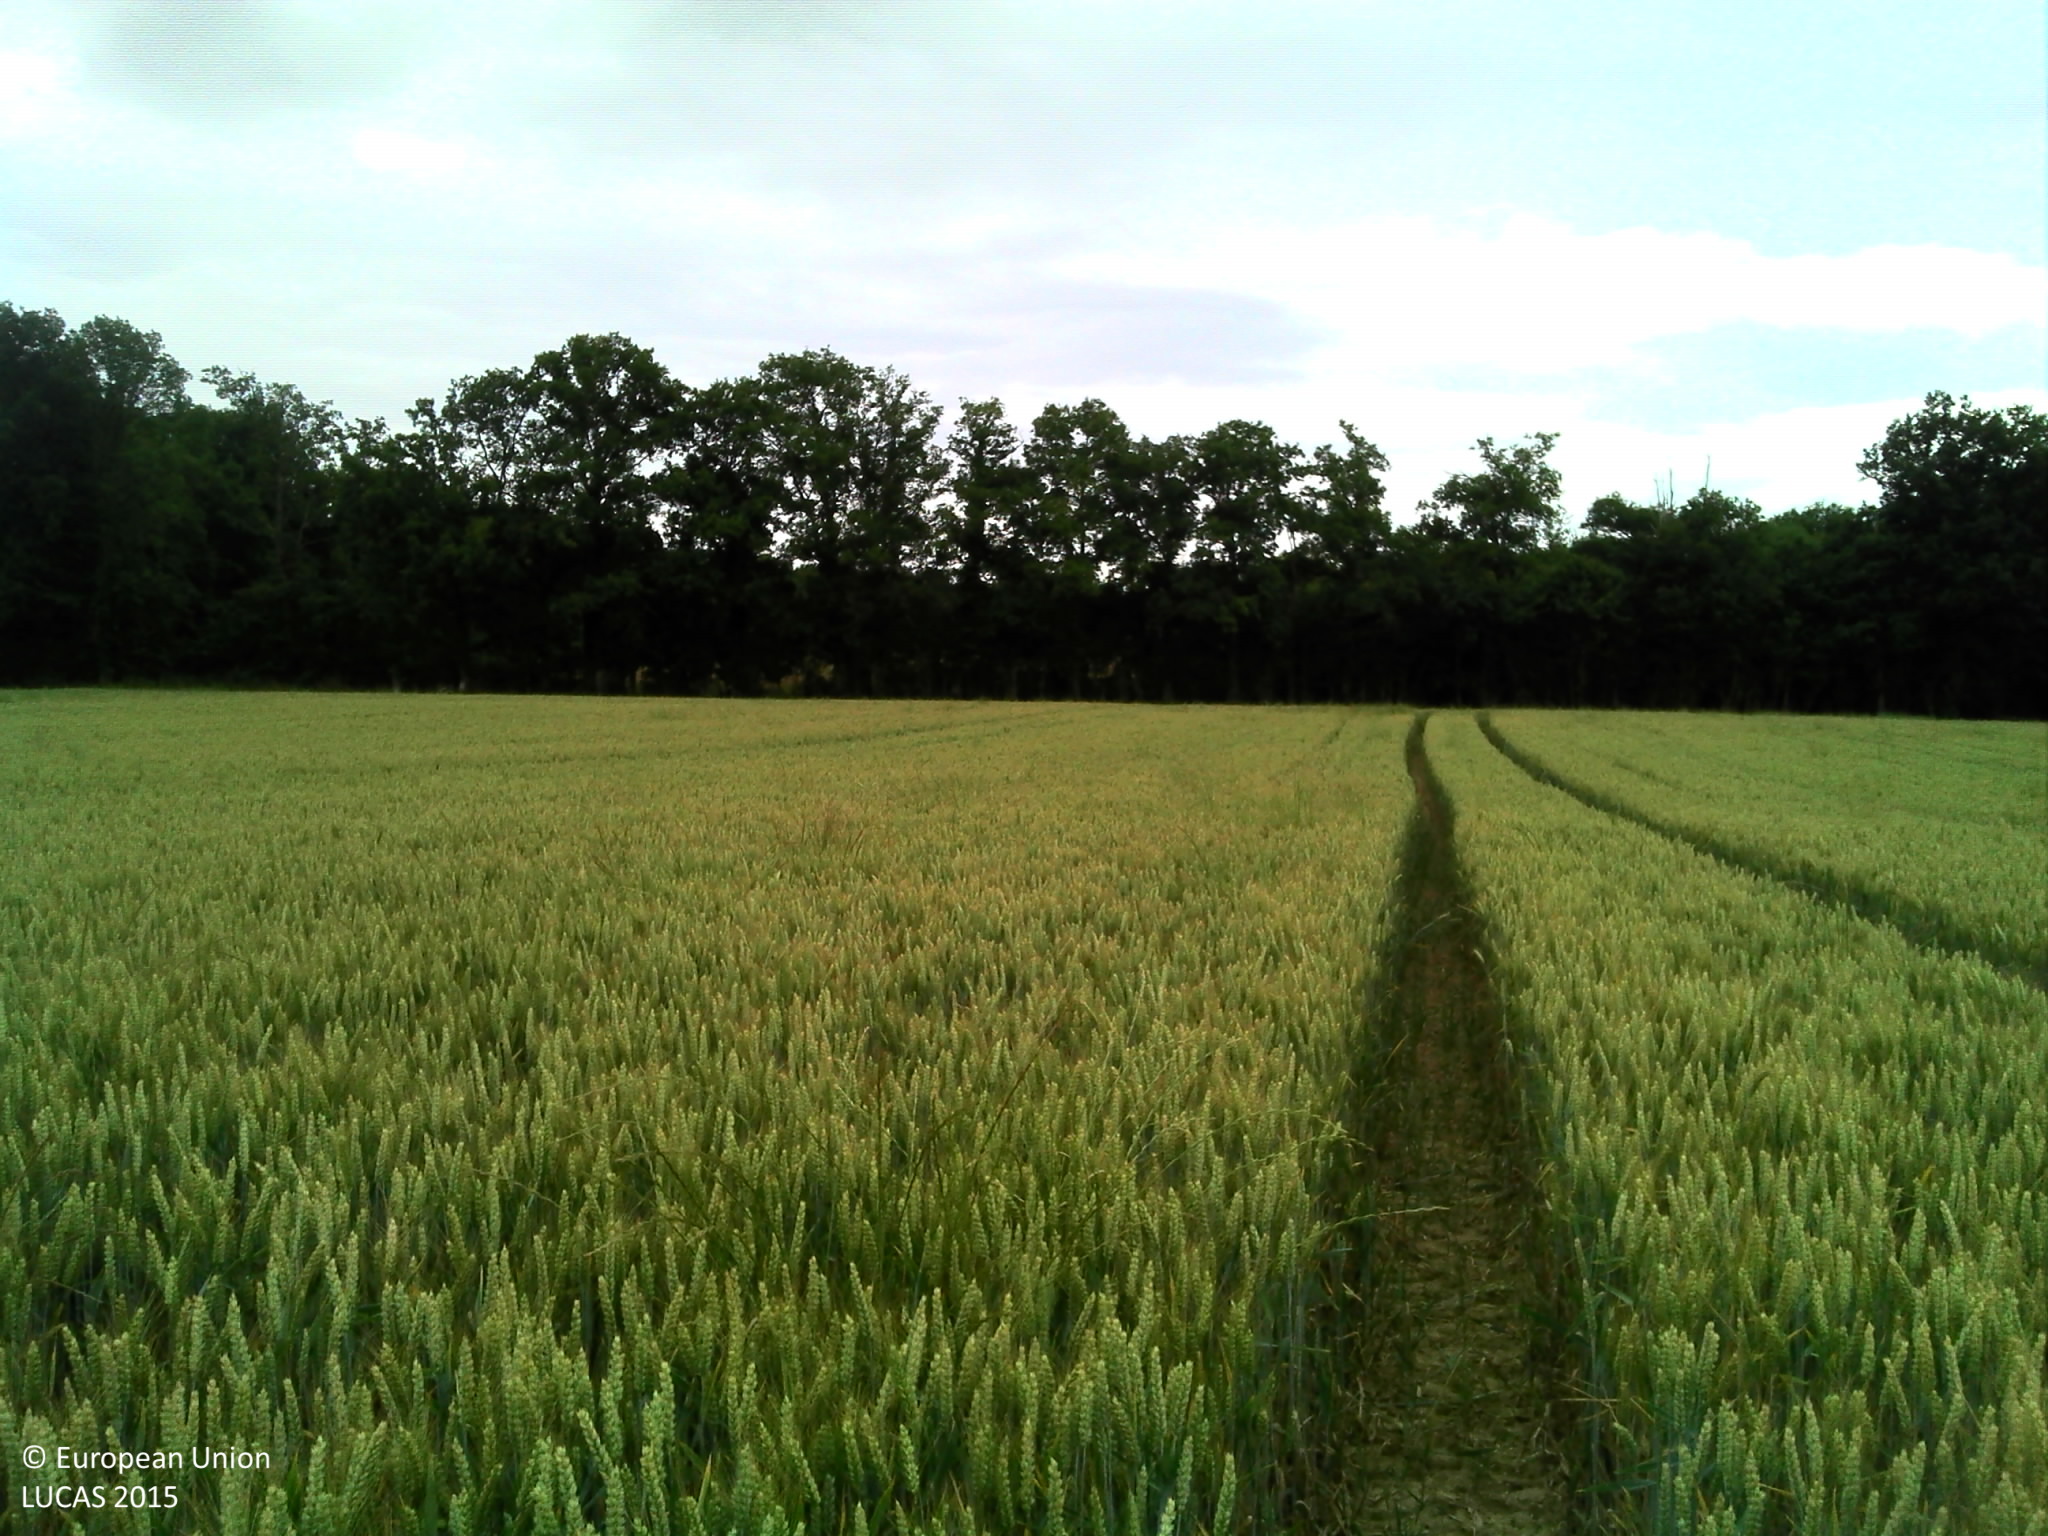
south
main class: Cropland
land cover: Common wheat
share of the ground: > 75 %
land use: Agriculture (excluding fallow land and kitchen gardens)
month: June
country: FR
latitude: 47.9432
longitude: -1.8715
